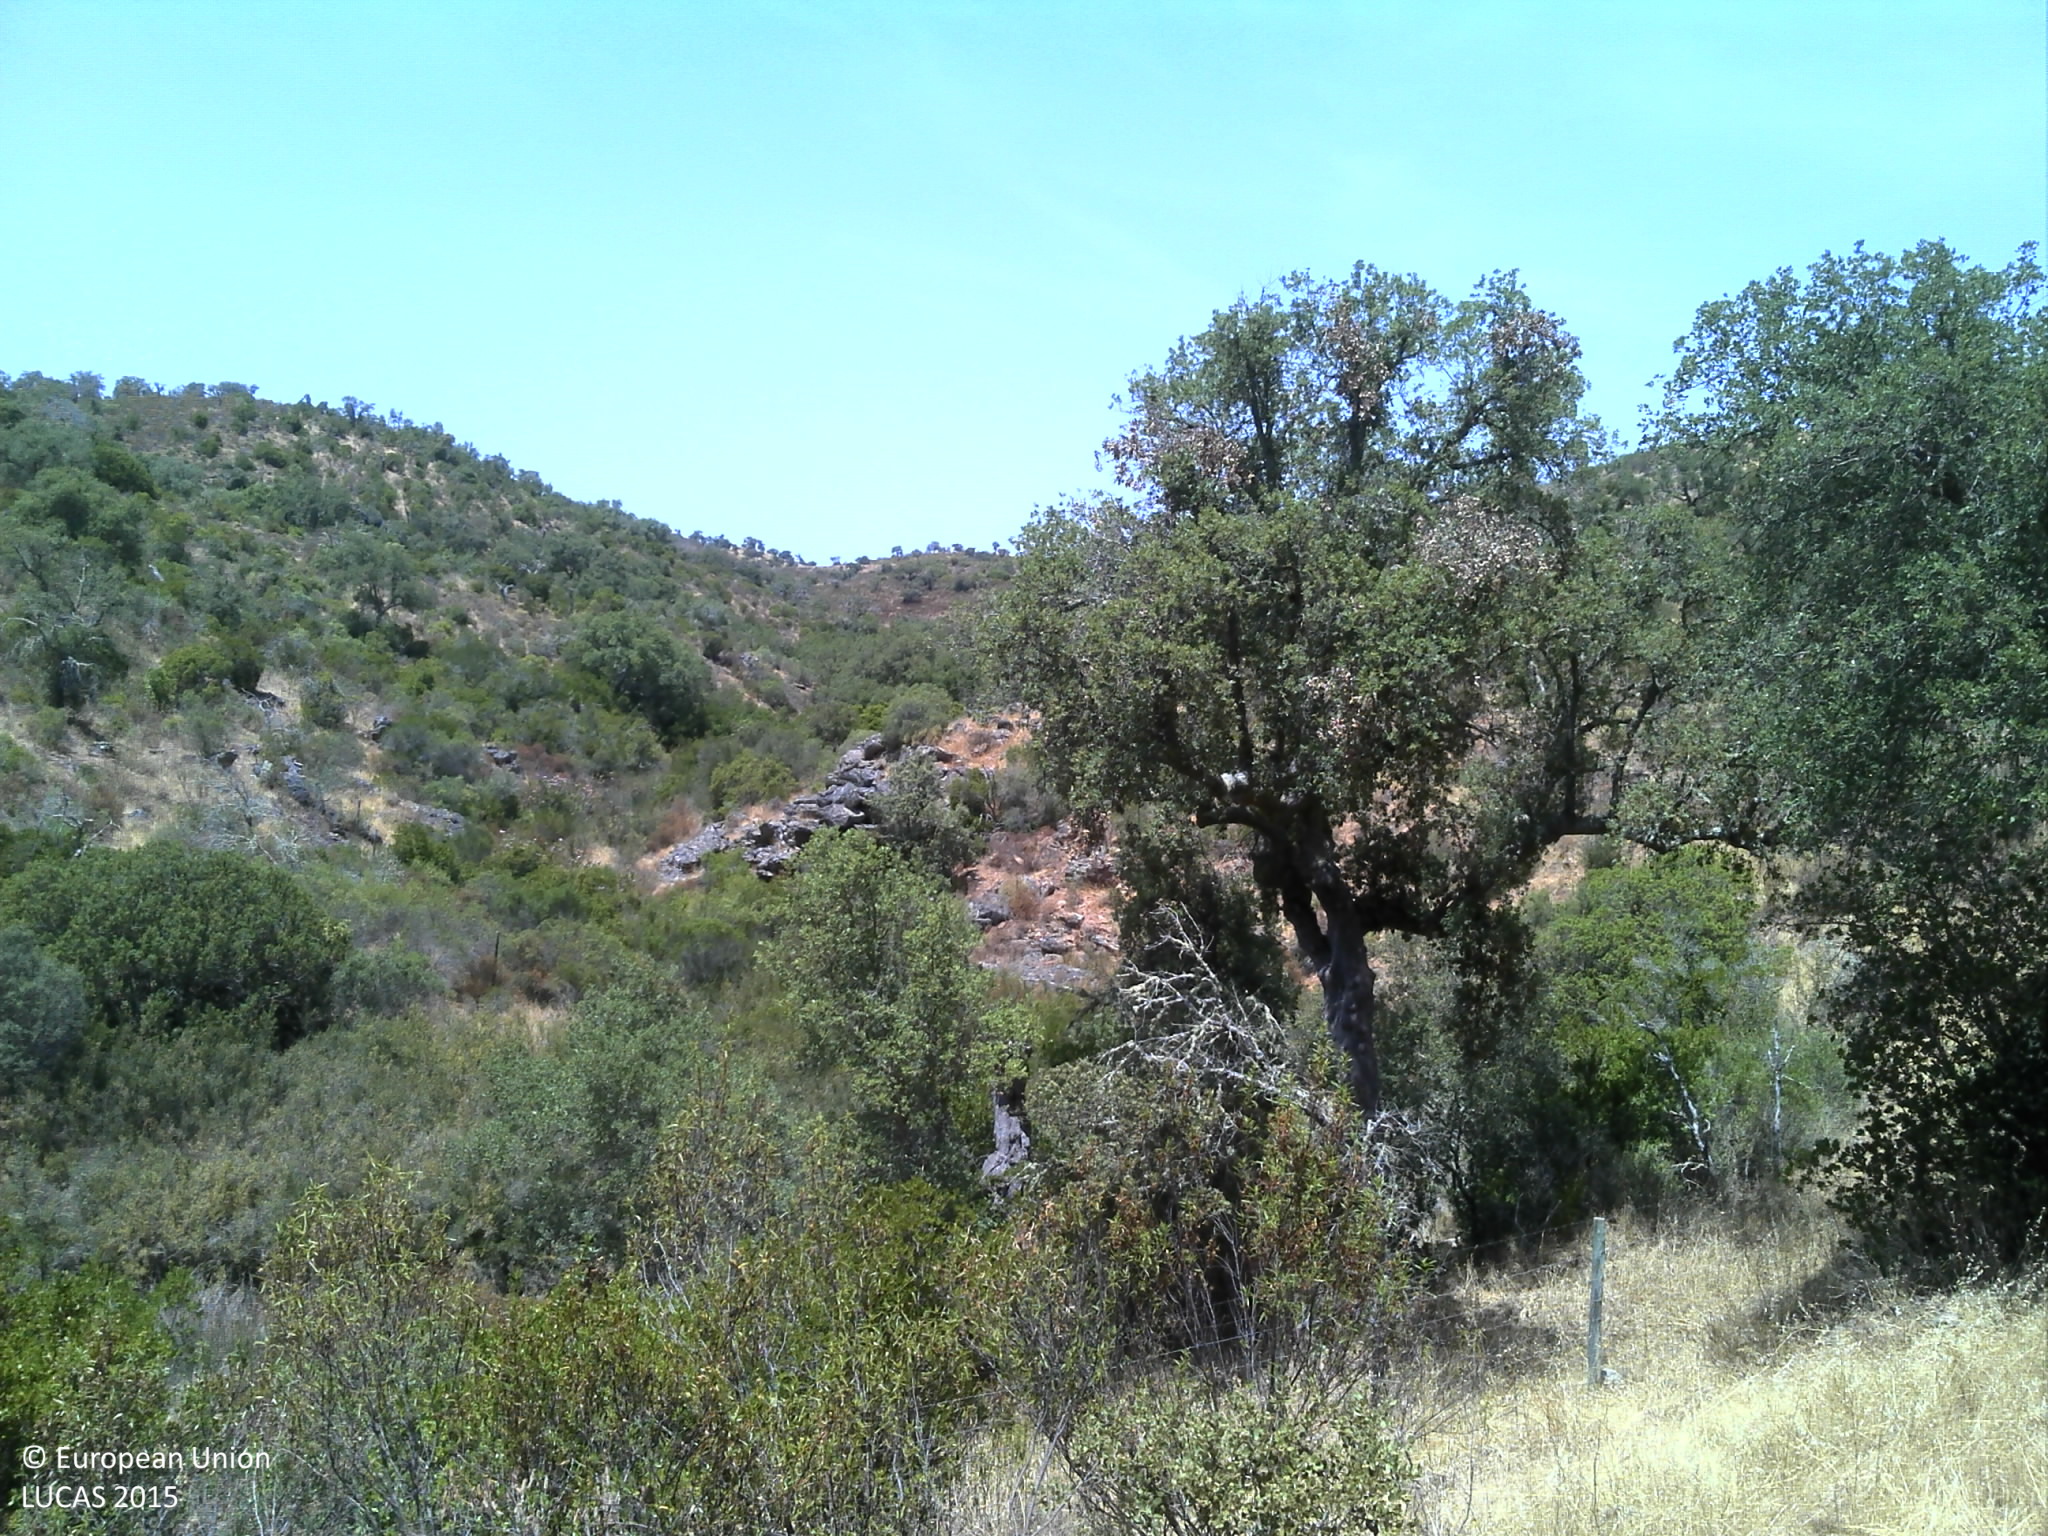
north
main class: Woodland
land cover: Broadleaved woodland
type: broadleaved evergreen forest
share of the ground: 25 - 50 %
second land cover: Shrubland without tree cover
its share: 25 - 50 %
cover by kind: unconsolidated bare surface 40 %, broadleaved forest trees 25 %, shrubs 25 %, herbaceous plants 10 %
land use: Forestry
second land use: Agriculture (excluding fallow land and kitchen gardens)
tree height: > 5 m
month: July
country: PT
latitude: 38.2573
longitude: -7.5910
